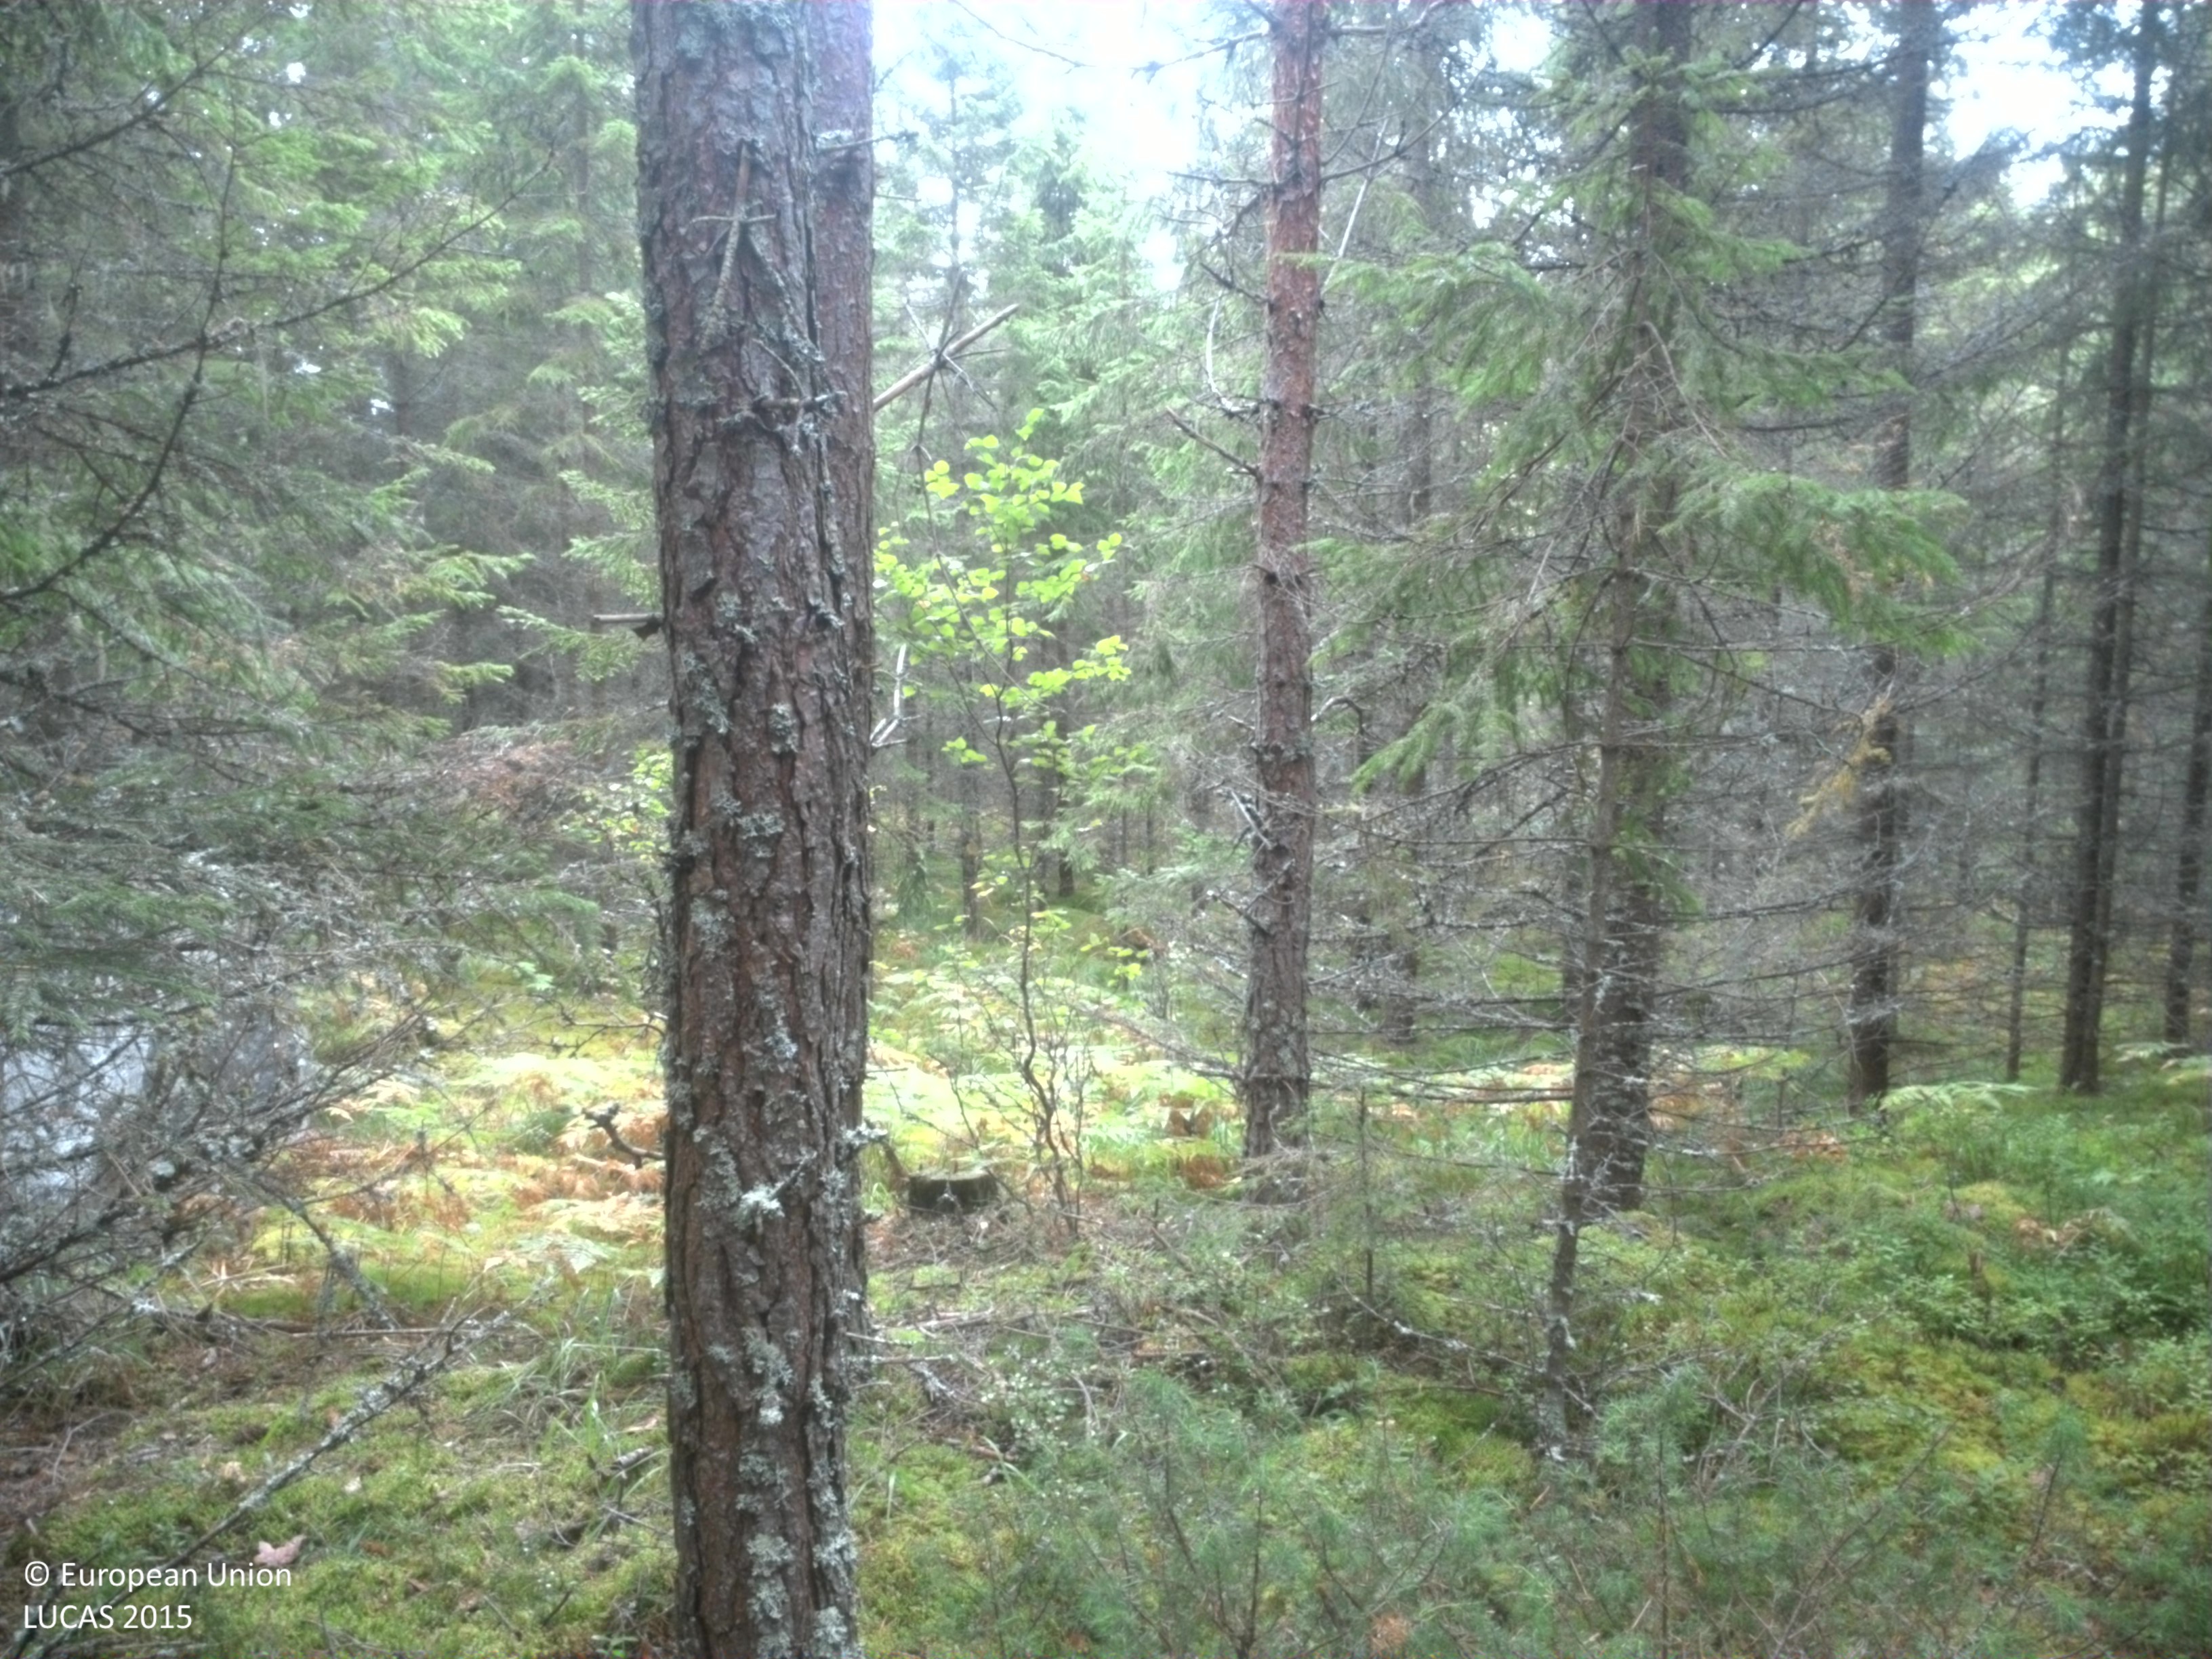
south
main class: Woodland
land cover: Other coniferous woodland
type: boreal forest
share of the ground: > 75 %
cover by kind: coniferous forest trees 75 %, lichens and mosses 15 %, shrubs 10 %
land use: Forestry
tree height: > 5 m
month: September
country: SE
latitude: 59.6523
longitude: 15.6512
